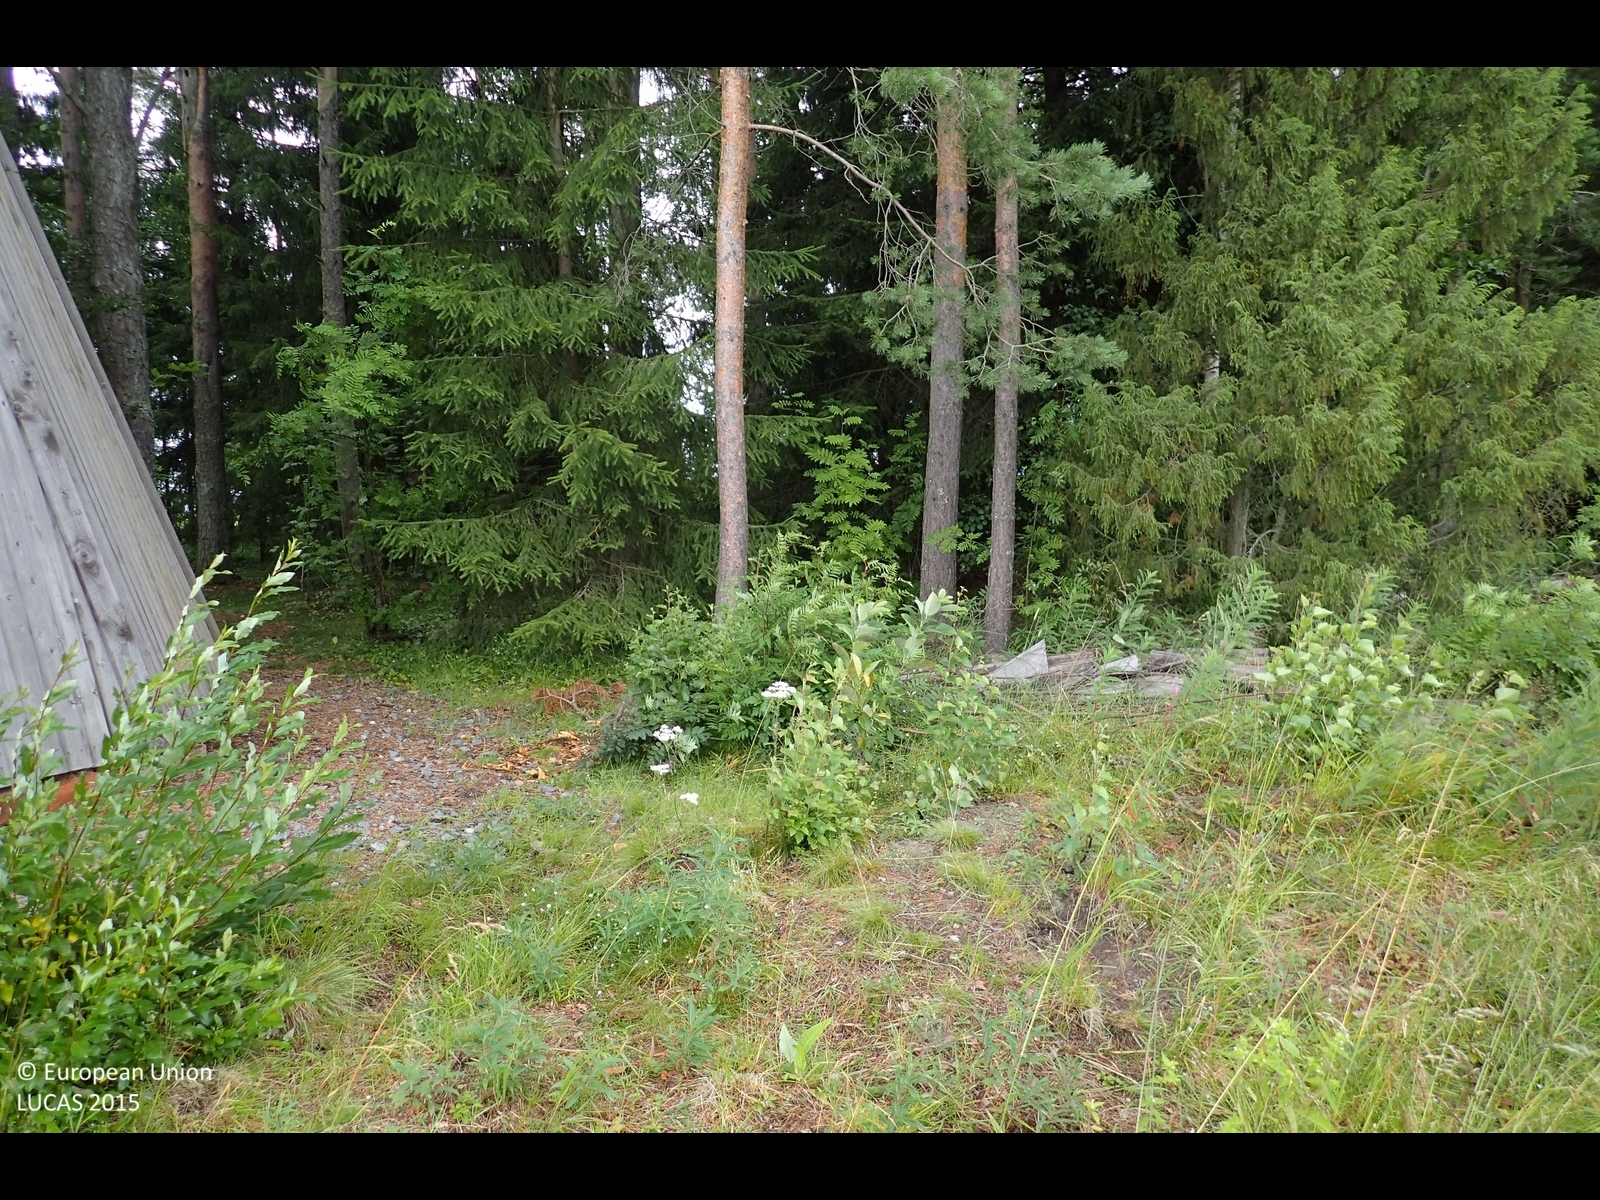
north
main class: Cropland
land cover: Barley
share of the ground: > 75 %
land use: Agriculture (excluding fallow land and kitchen gardens)
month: July
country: FI
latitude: 62.7959
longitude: 22.5833
